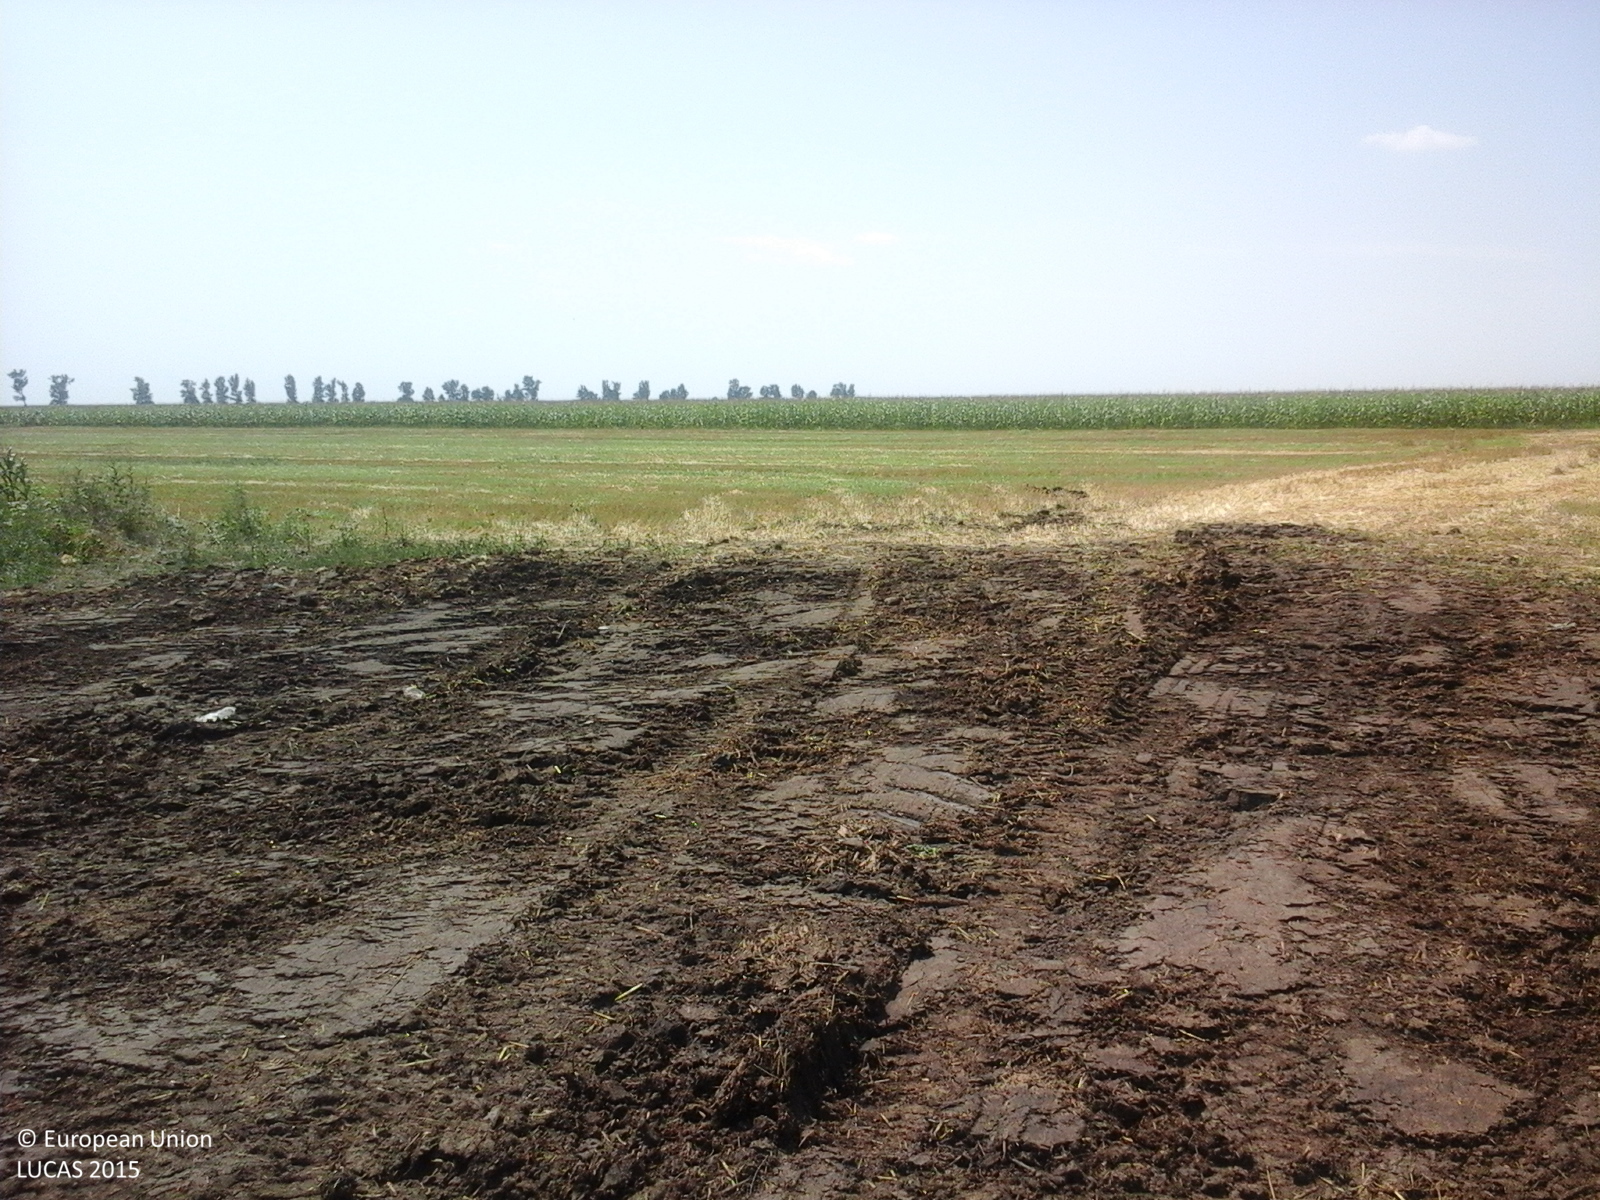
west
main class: Cropland
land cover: Maize
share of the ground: > 75 %
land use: Agriculture (excluding fallow land and kitchen gardens)
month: July
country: RO
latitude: 44.7235
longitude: 27.0895
